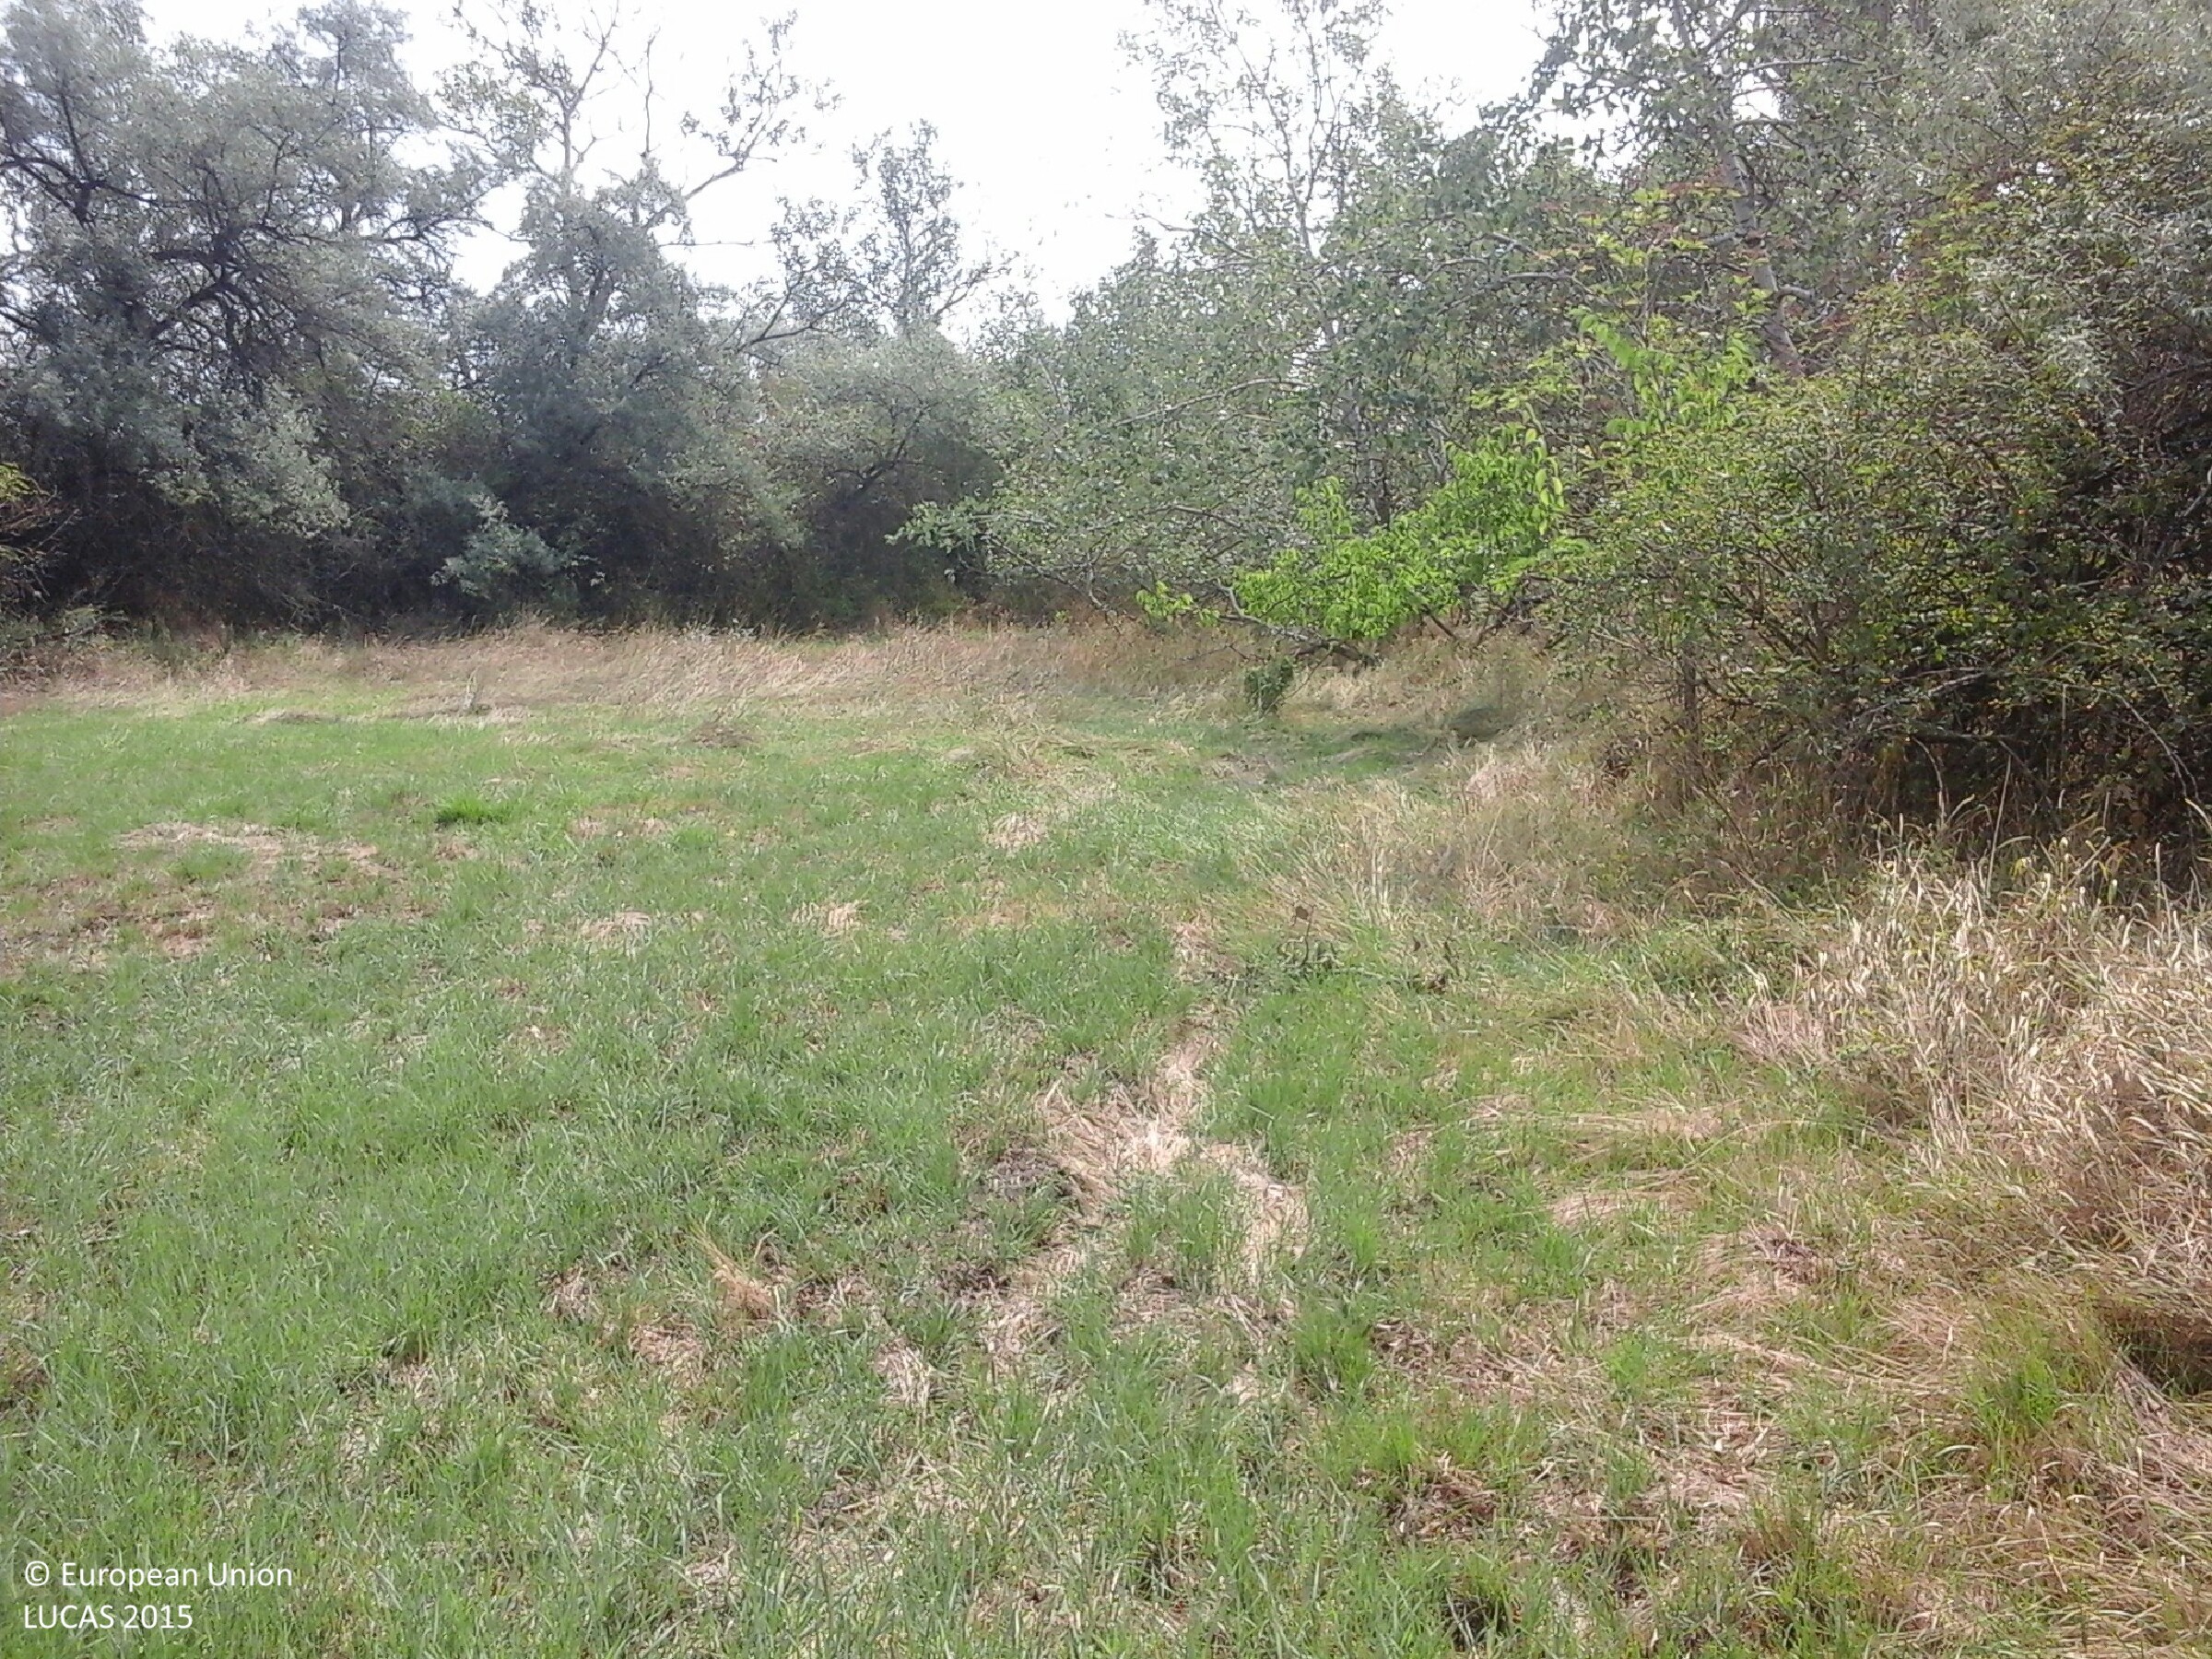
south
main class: Grassland
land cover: Grassland without tree/shrub cover
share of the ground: > 75 %
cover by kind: herbaceous plants 100 %
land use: Forestry
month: August
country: HU
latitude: 47.5603
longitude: 20.8401
